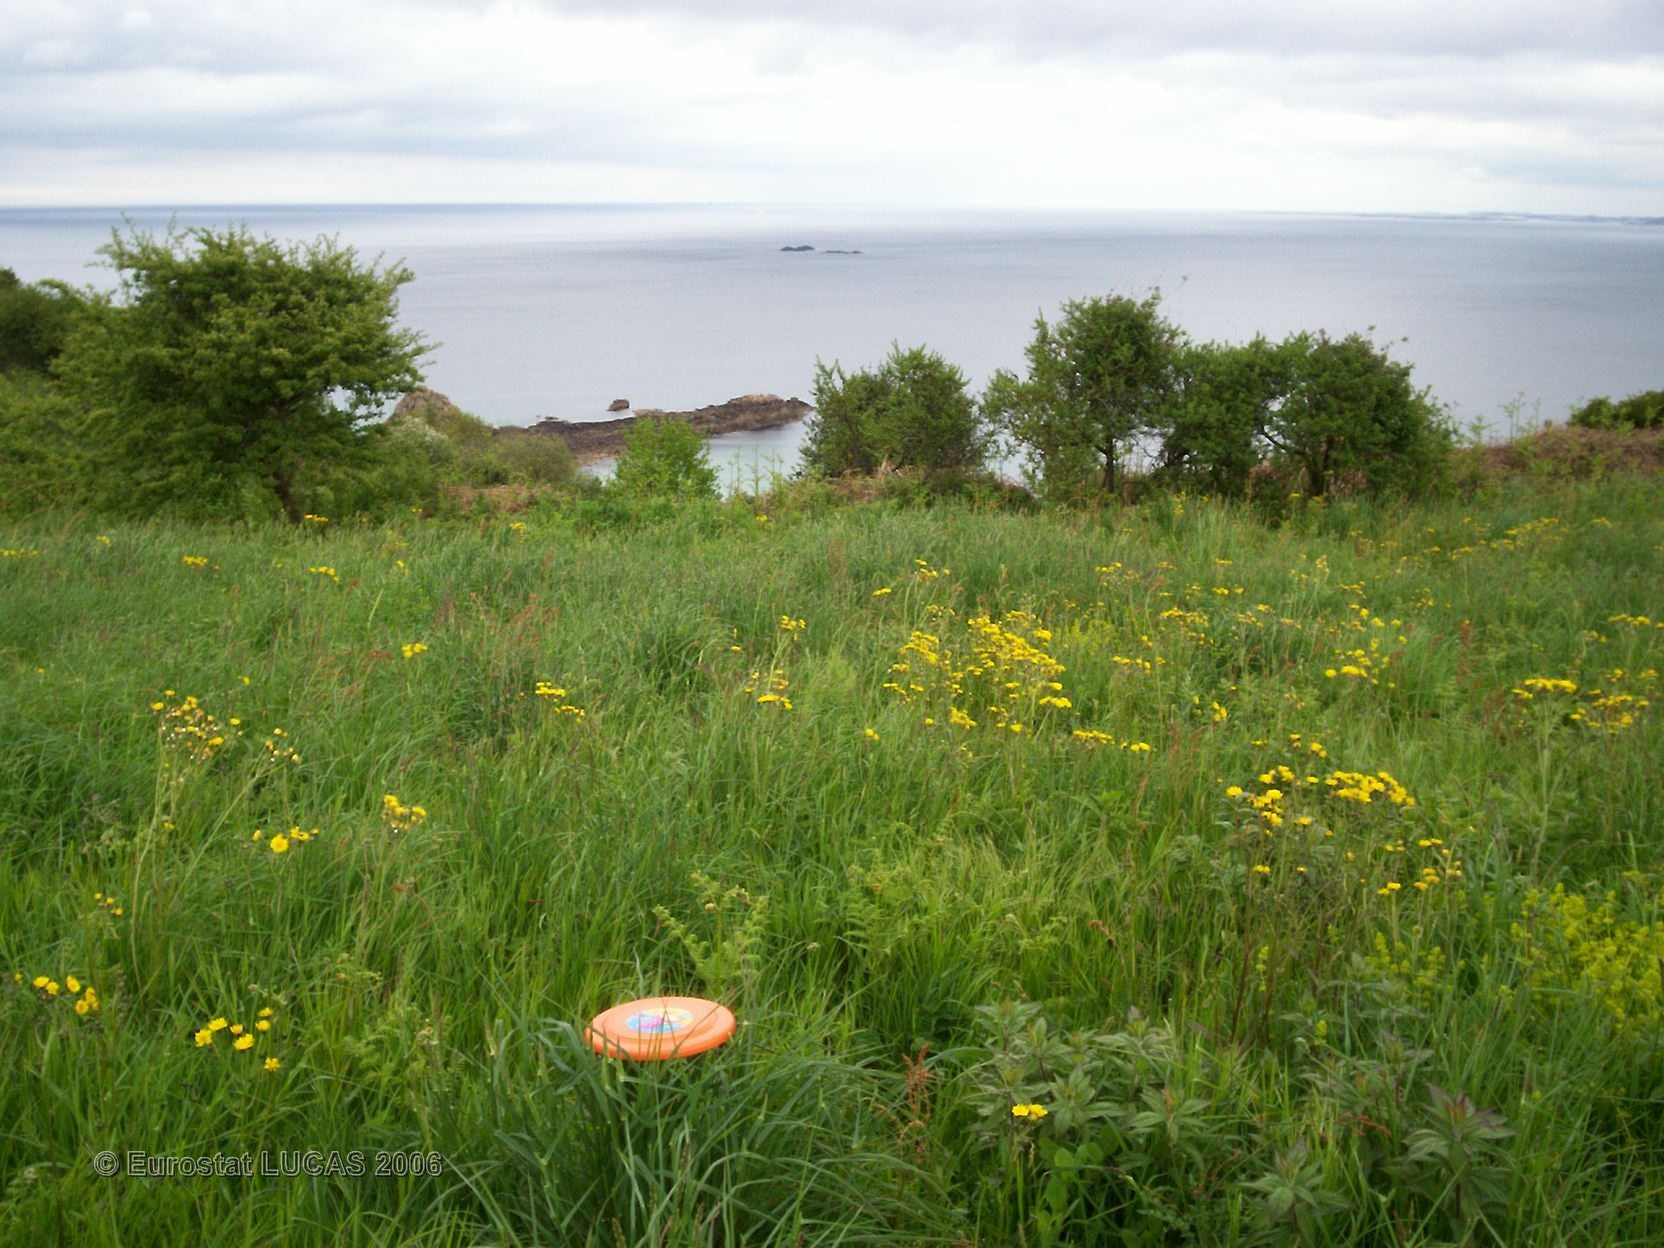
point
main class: Grassland
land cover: Grassland without tree/shrub cover
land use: Agriculture (excluding fallow land and kitchen gardens)
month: May
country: FR
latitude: 48.6941
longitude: -3.7101
